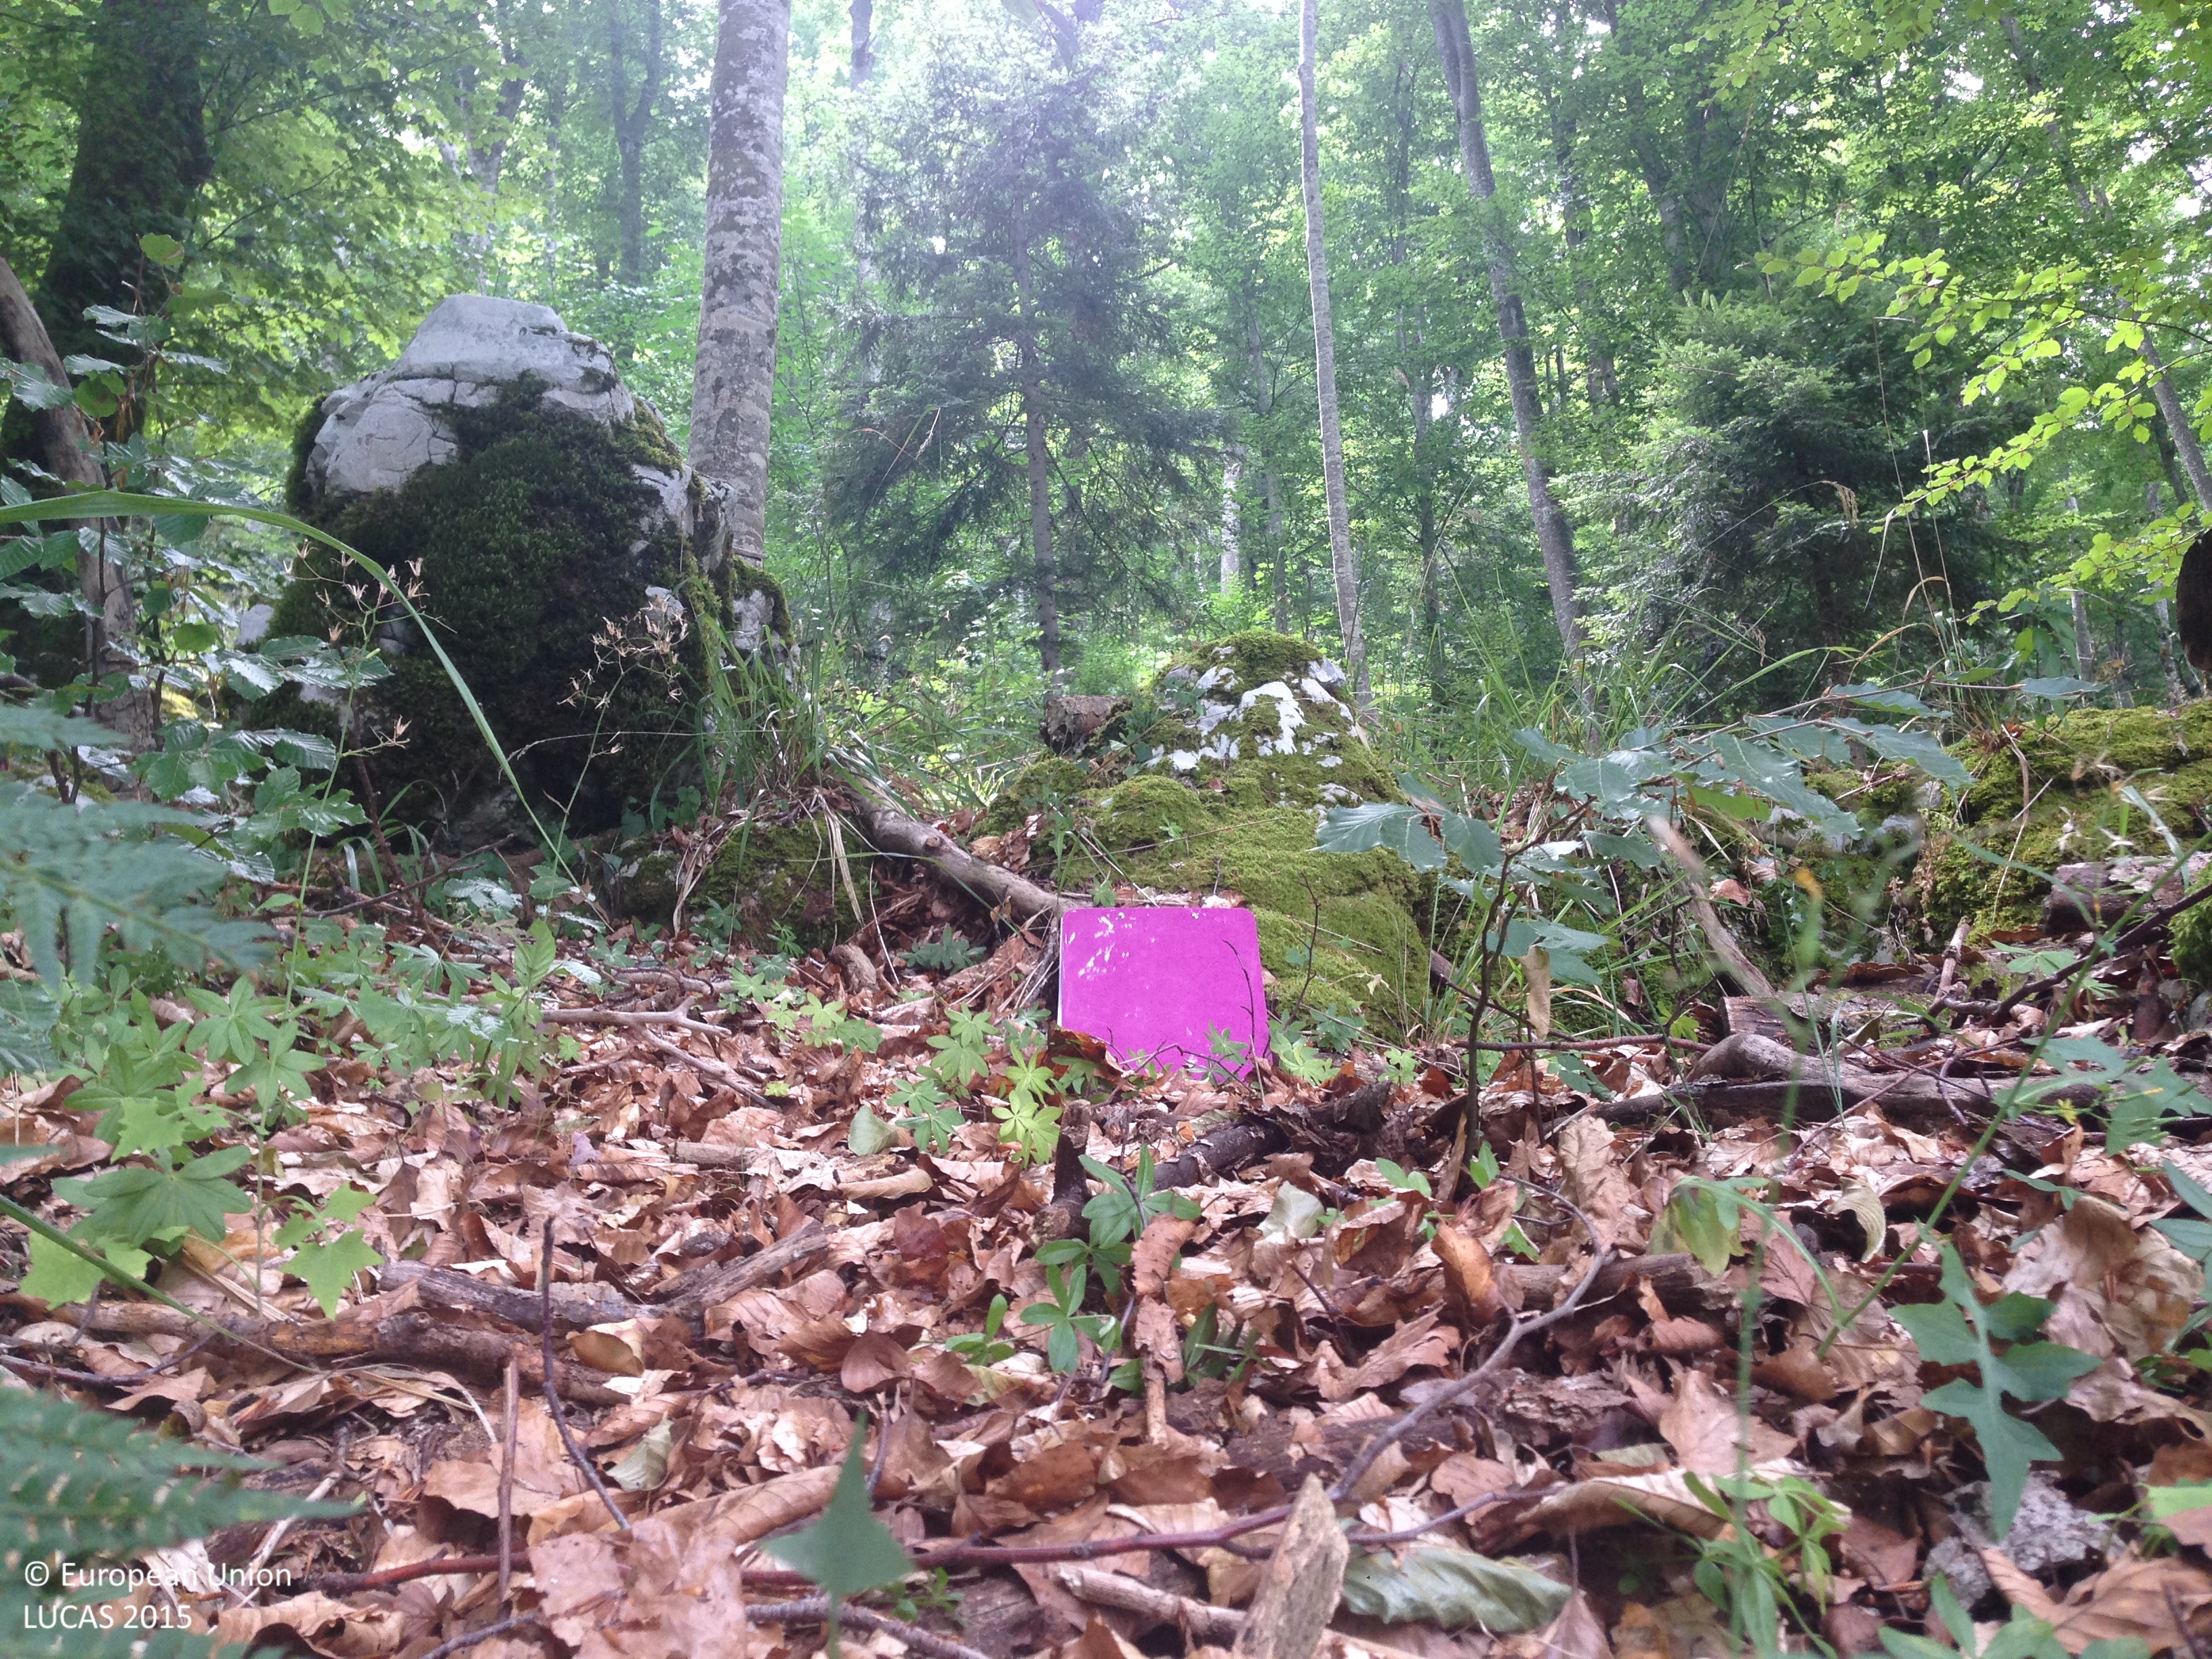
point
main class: Woodland
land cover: Other mixed woodland
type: thermophilous deciduous forest
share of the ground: > 75 %
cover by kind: broadleaved forest trees 55 %, coniferous forest trees 45 %
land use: Forestry
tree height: > 5 m
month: July
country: HR
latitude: 44.7964
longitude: 15.2401
